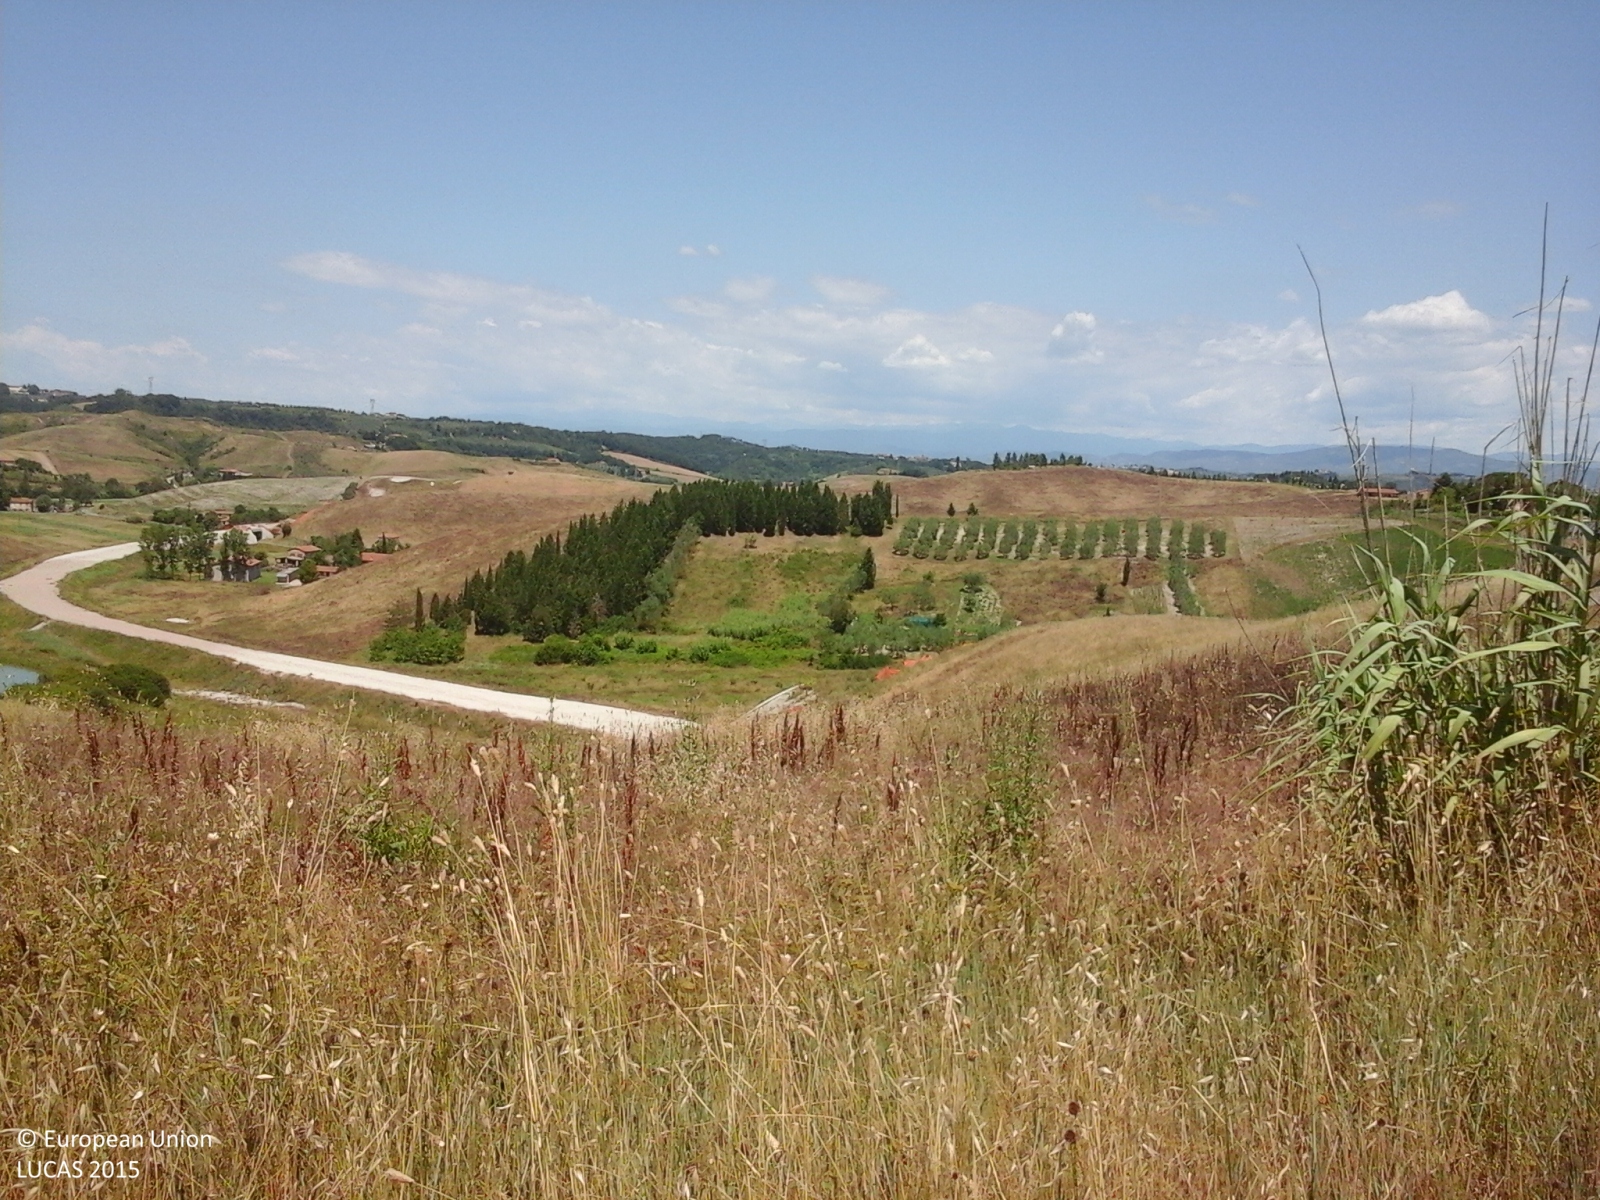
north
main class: Grassland
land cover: Grassland without tree/shrub cover
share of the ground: > 75 %
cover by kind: herbaceous plants 95 %, shrubs 5 %
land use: Agriculture (excluding fallow land and kitchen gardens)
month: June
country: IT
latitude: 43.5884
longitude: 10.9511
